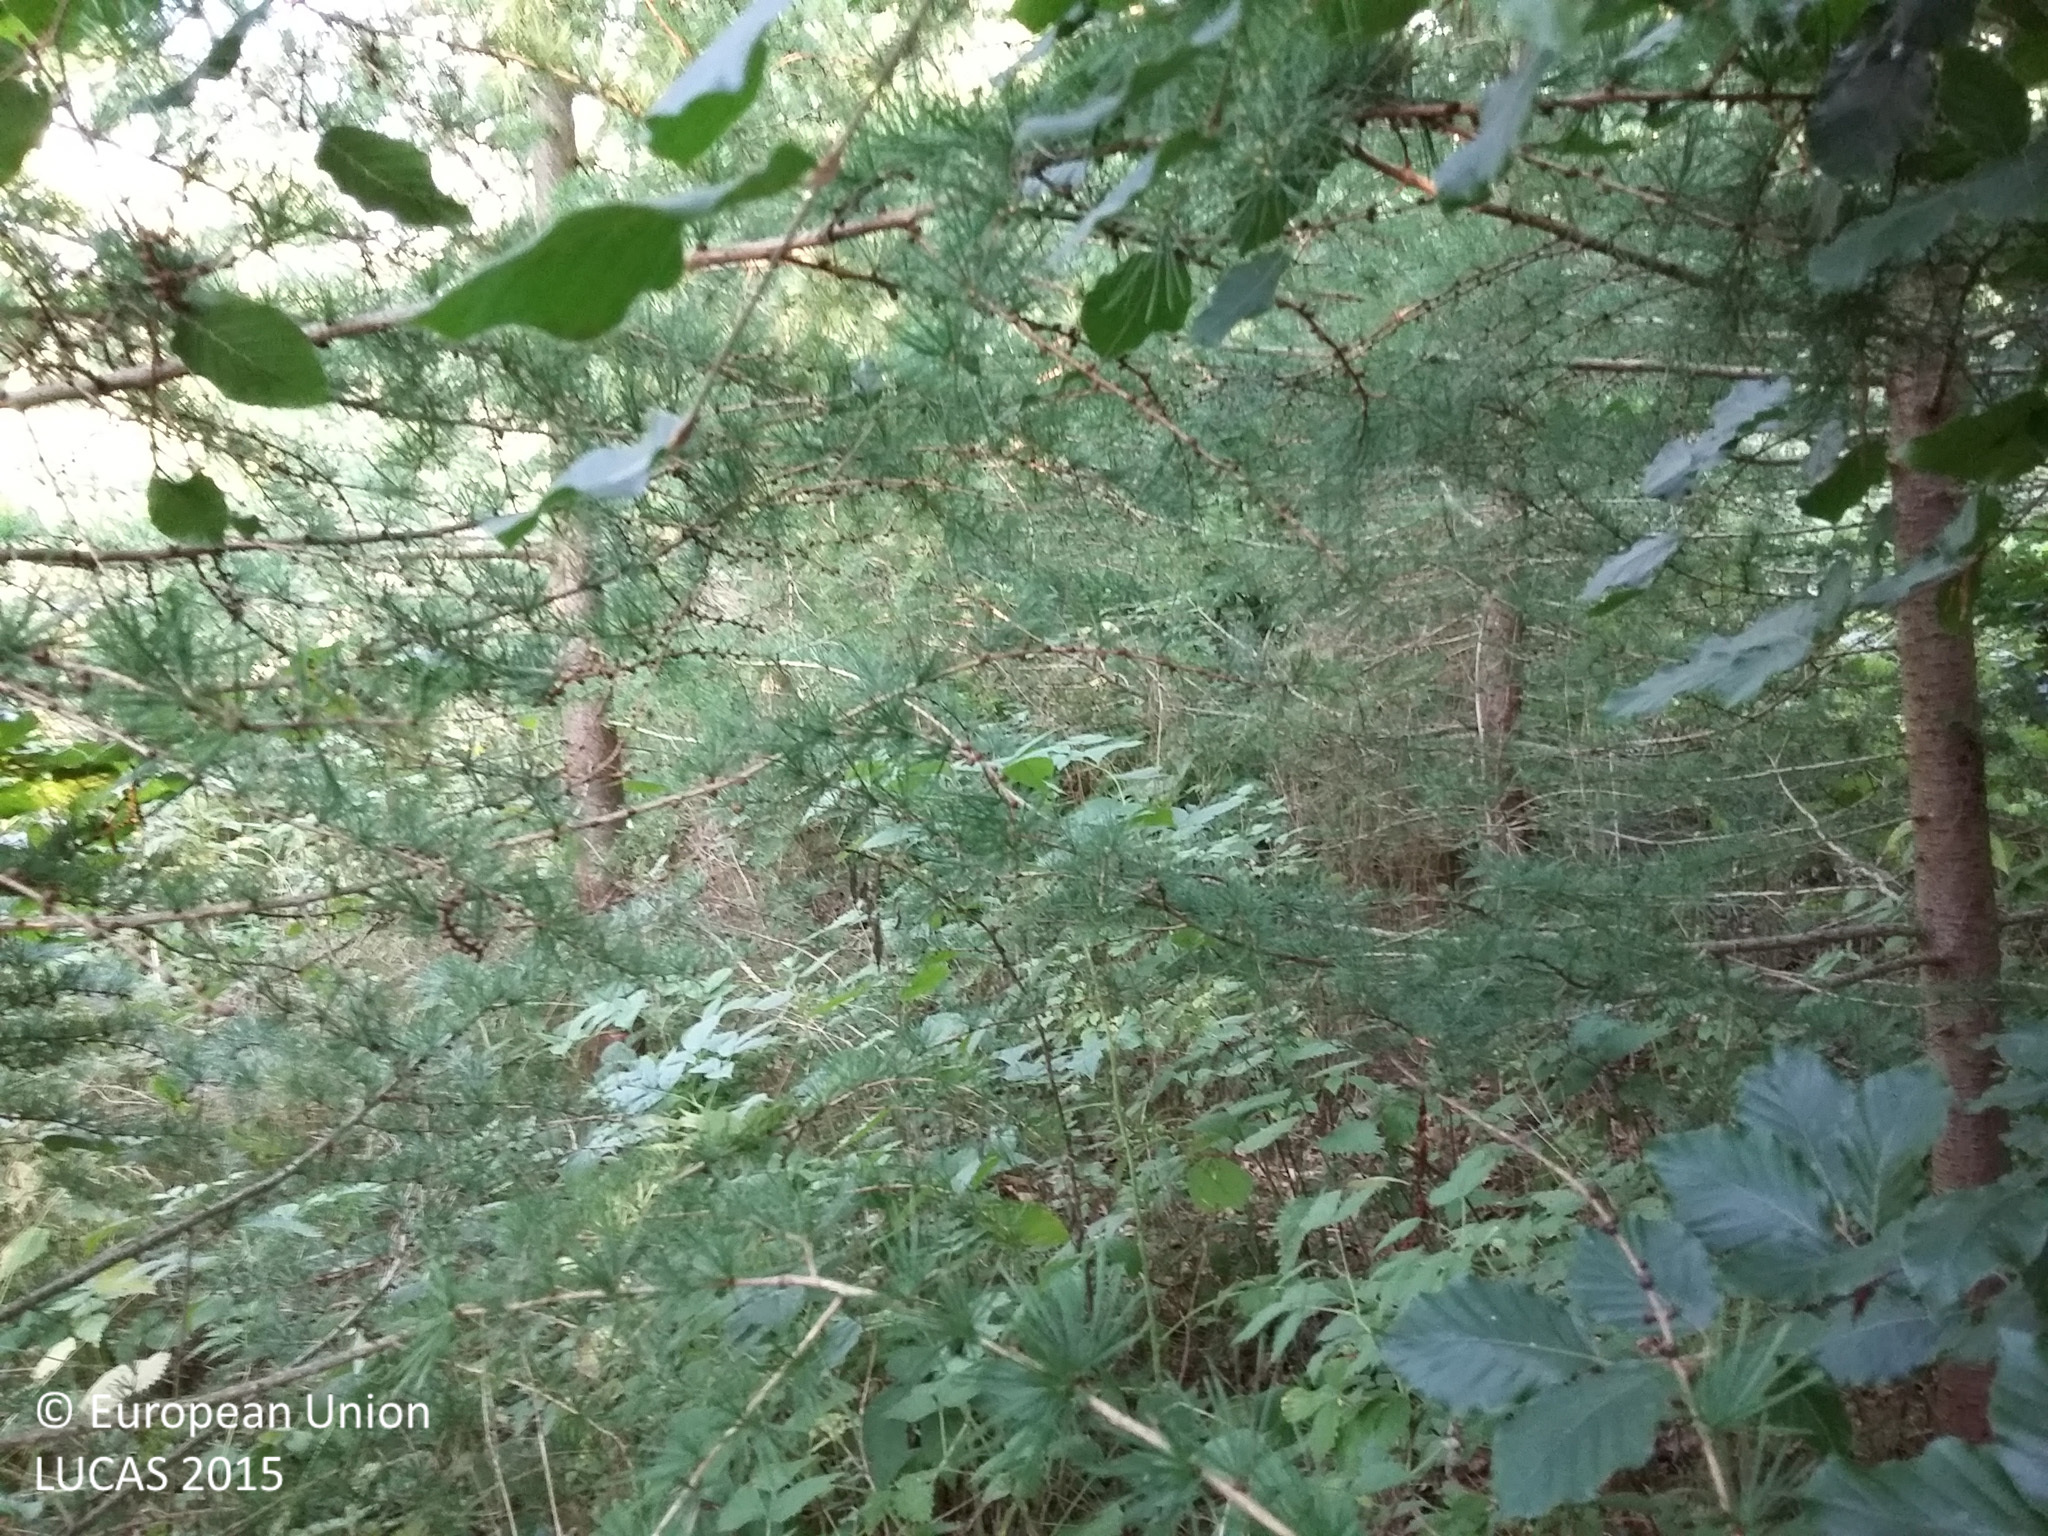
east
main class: Woodland
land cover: Other mixed woodland
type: beech forest
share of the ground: > 75 %
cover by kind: coniferous forest trees 50 %, broadleaved forest trees 40 %, shrubs 5 %, herbaceous plants 5 %
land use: Forestry
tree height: > 5 m
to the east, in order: Other mixed woodland; Fences; Spruce dominated coniferous woodland; Fences; Broadleaved woodland; Rivers and streams; Broadleaved woodland; Grassland without tree/shrub cover; Fences; Broadleaved woodland; Ditches and canals; Broadleaved woodland
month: August
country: DK
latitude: 55.3625
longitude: 12.0335
